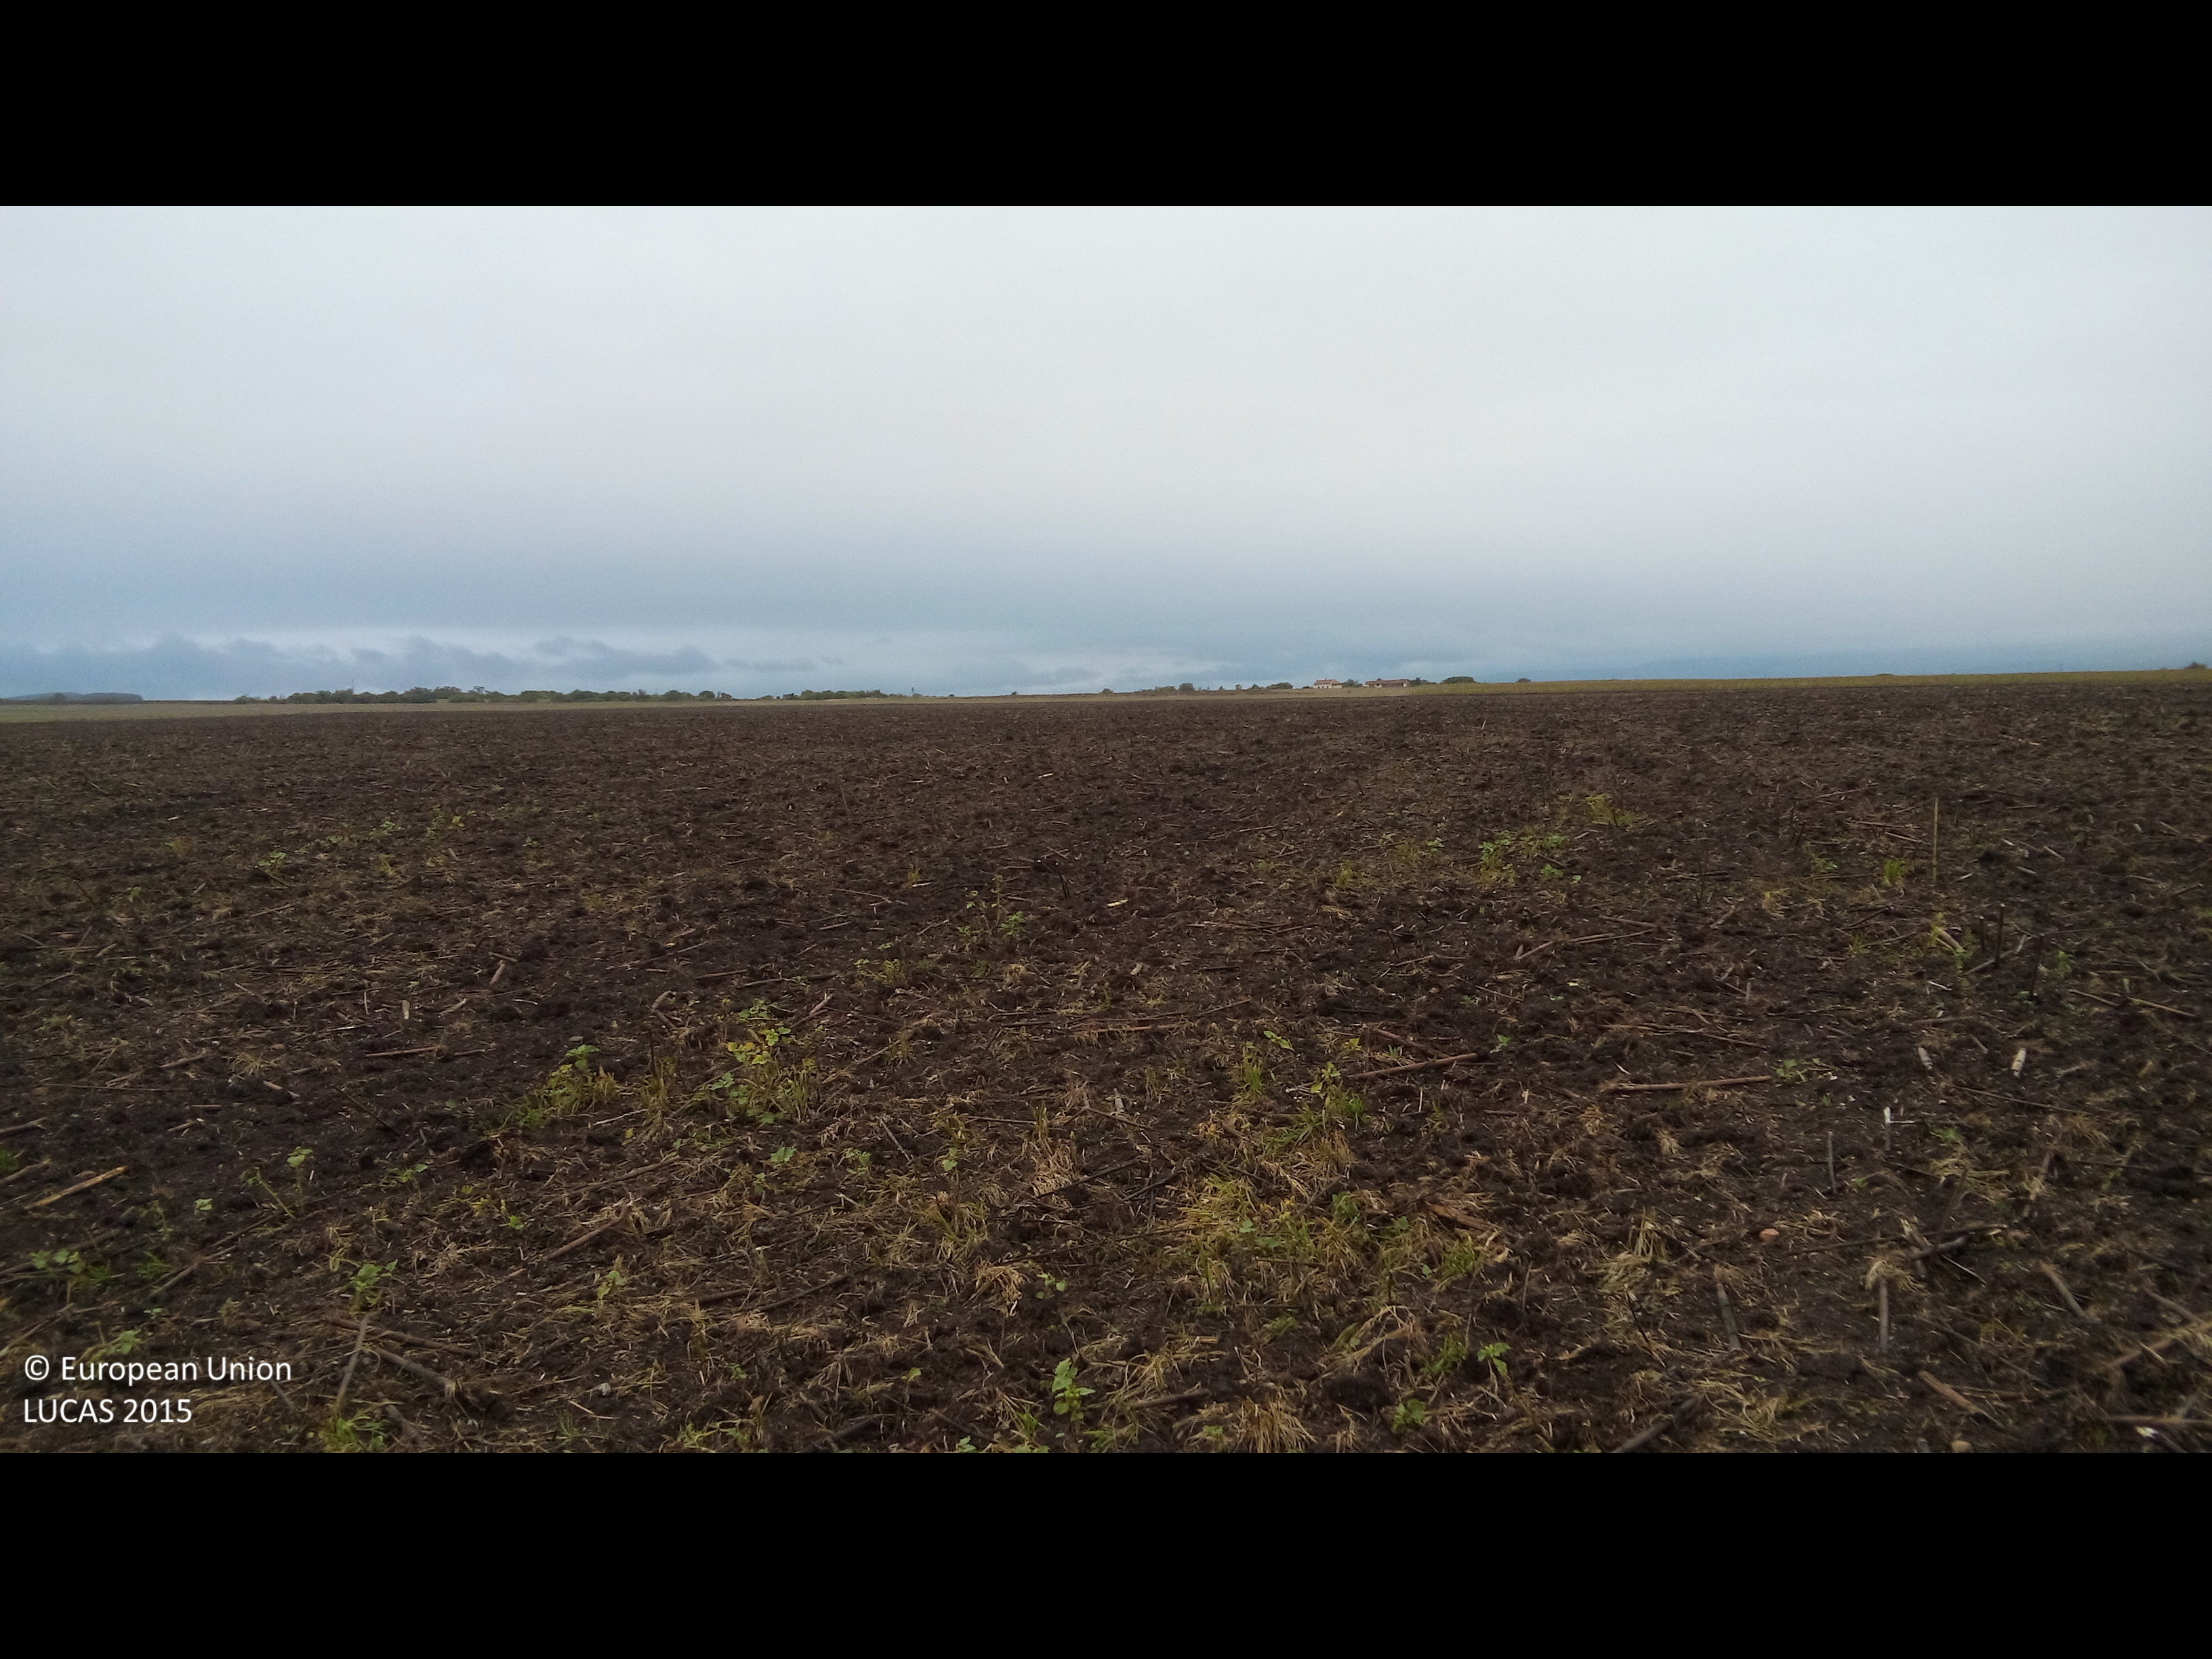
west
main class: Cropland
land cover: Sunflower
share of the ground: 10 - 25 %
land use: Agriculture (excluding fallow land and kitchen gardens)
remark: Harvested field
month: September
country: BG
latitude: 42.7376
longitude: 23.1882
